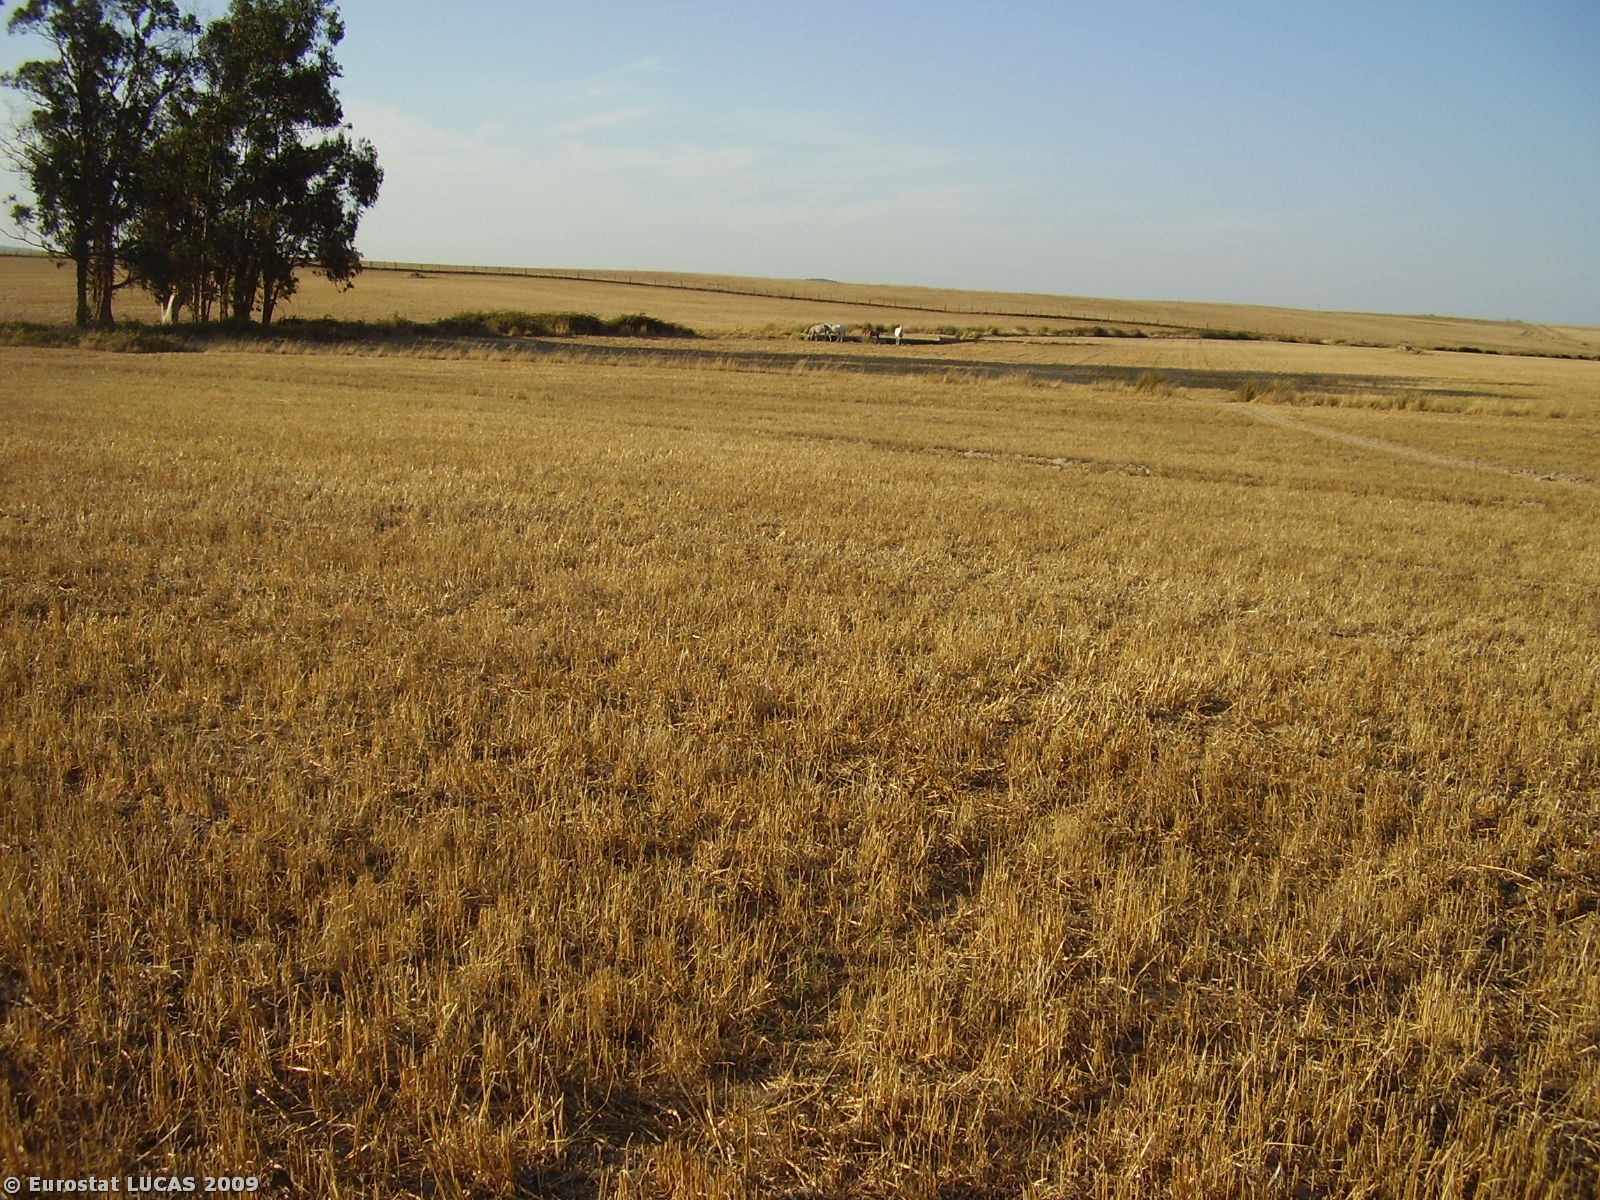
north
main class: Cropland
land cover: Oats
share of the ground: > 75 %
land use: Agriculture (excluding fallow land and kitchen gardens)
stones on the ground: 10 - 25 %
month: July
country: PT
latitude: 38.6192
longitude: -7.8293
